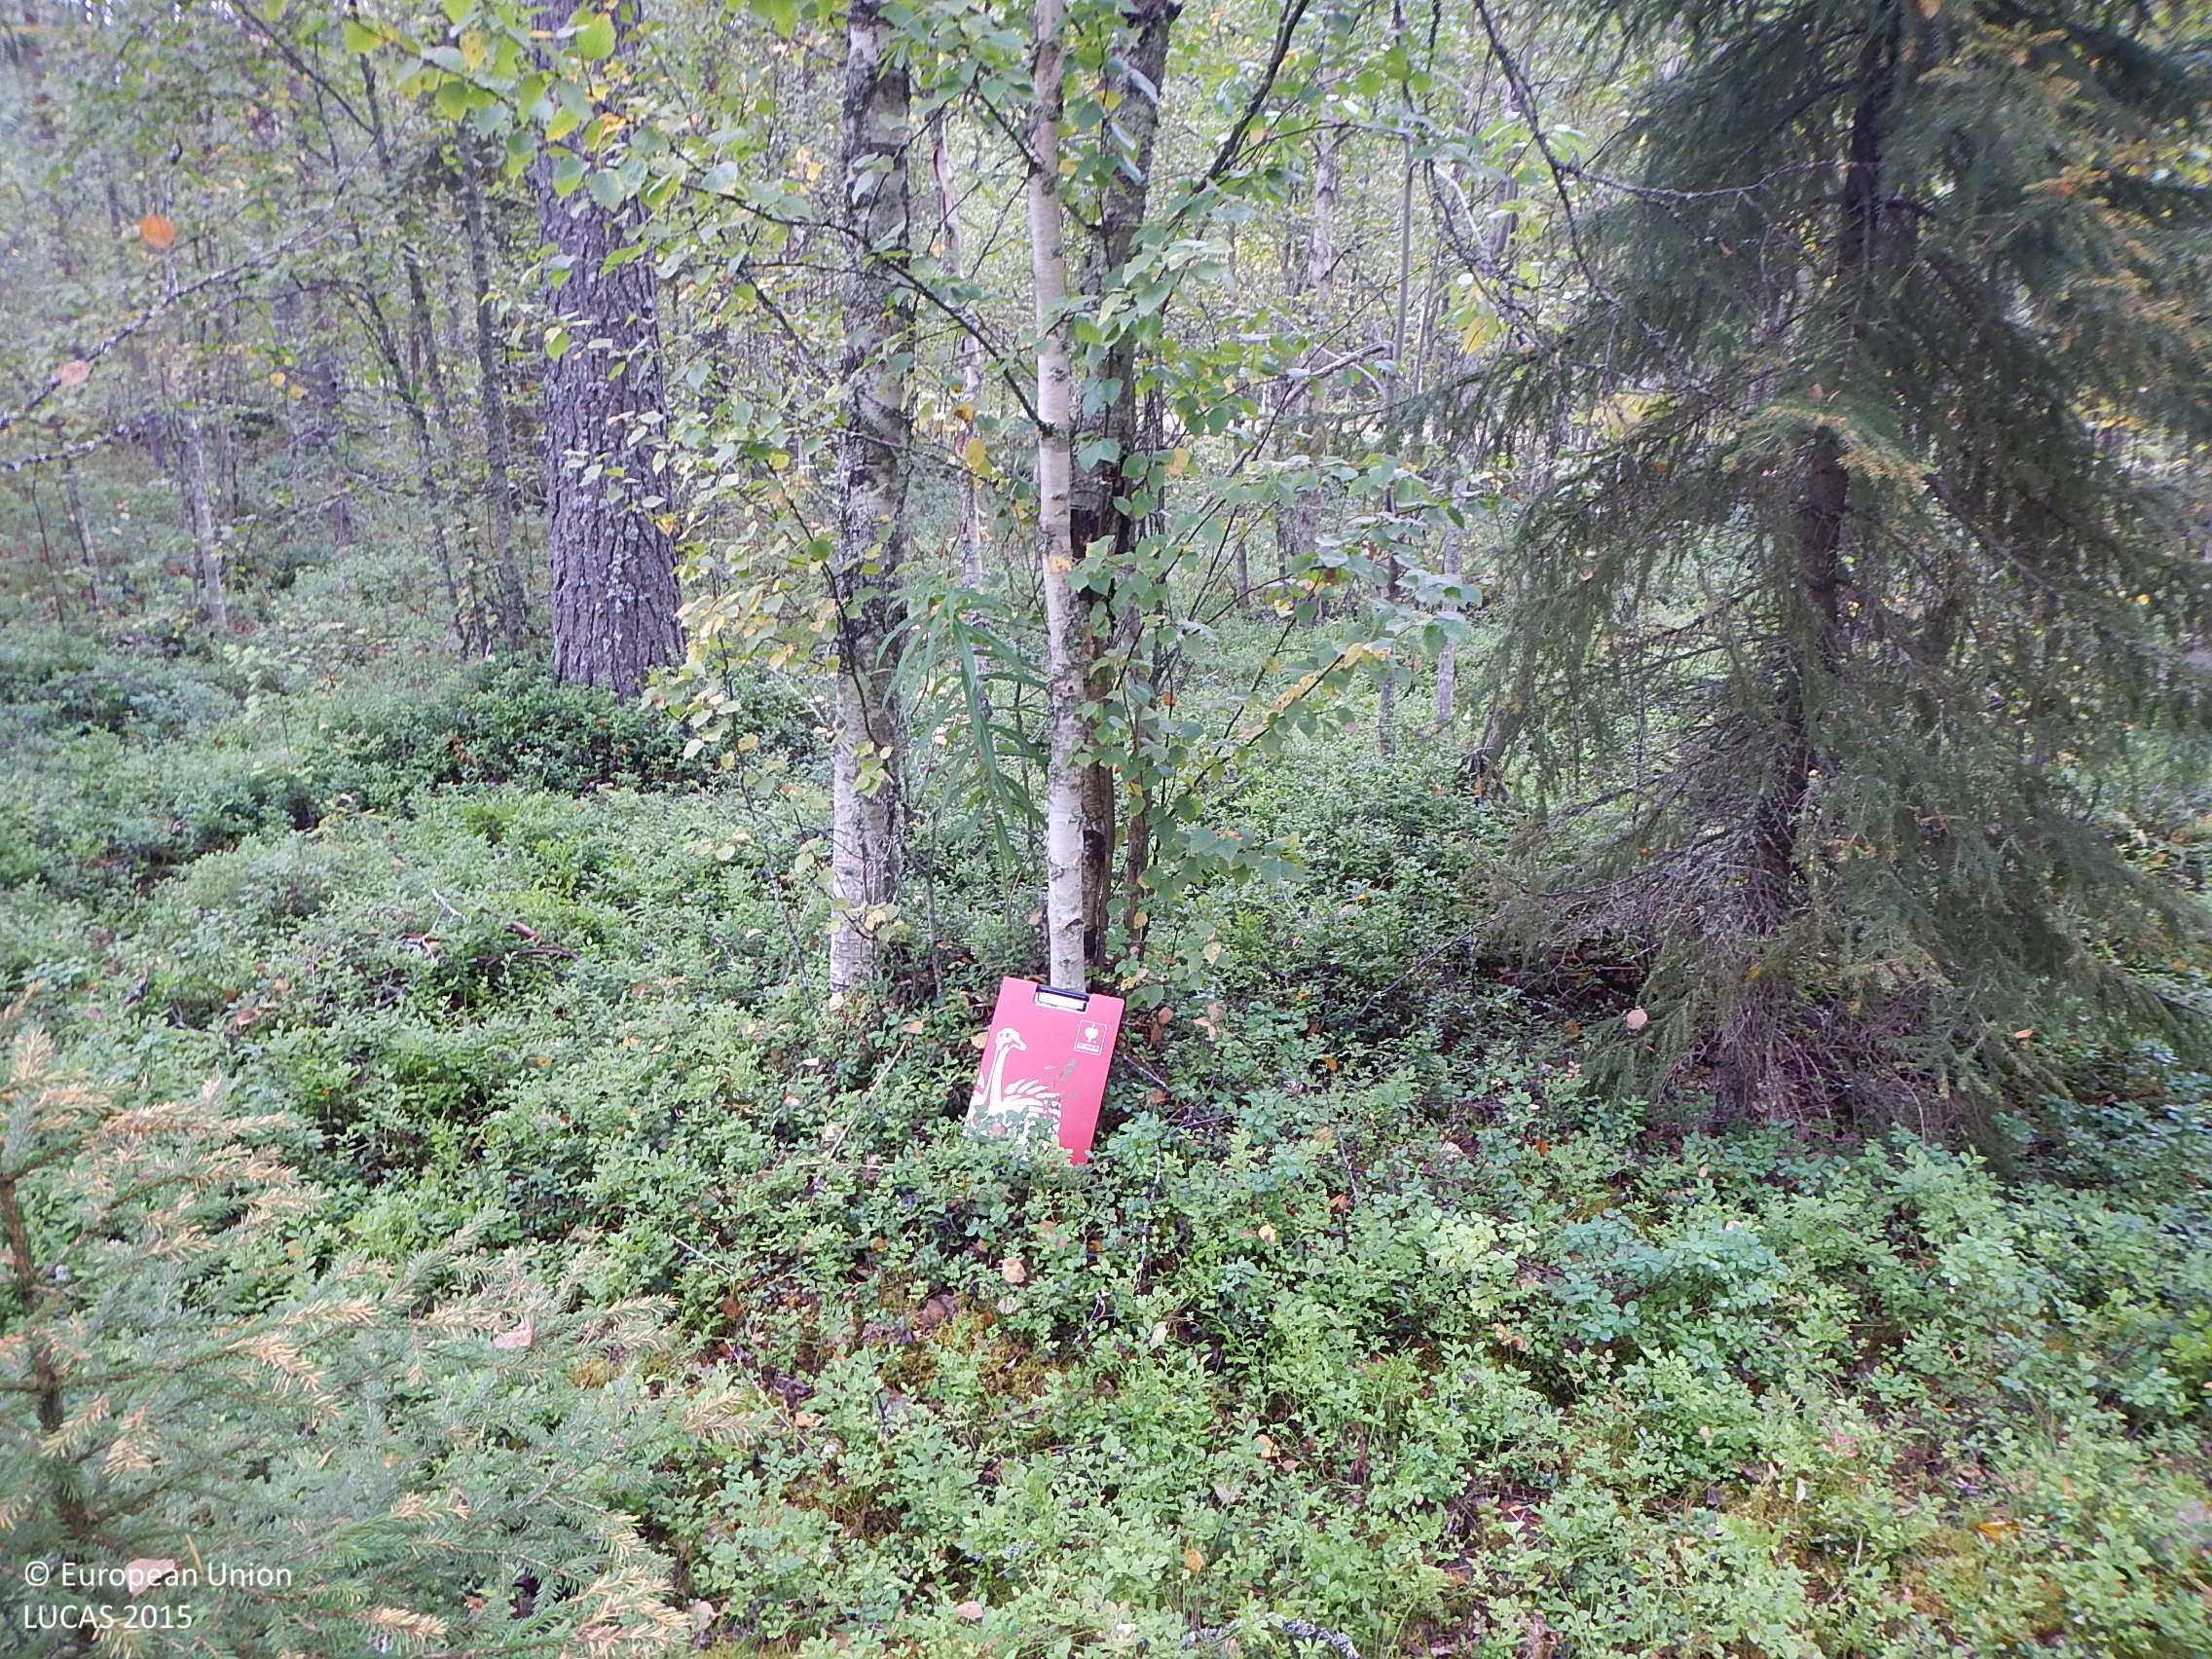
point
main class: Woodland
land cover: Pine dominated mixed woodland
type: boreal forest
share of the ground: 50 - 75 %
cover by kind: coniferous forest trees 35 %, shrubs 35 %, broadleaved forest trees 25 %, lichens and mosses 5 %
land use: Forestry
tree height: > 5 m
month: August
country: FI
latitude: 65.9332
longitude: 27.0987
